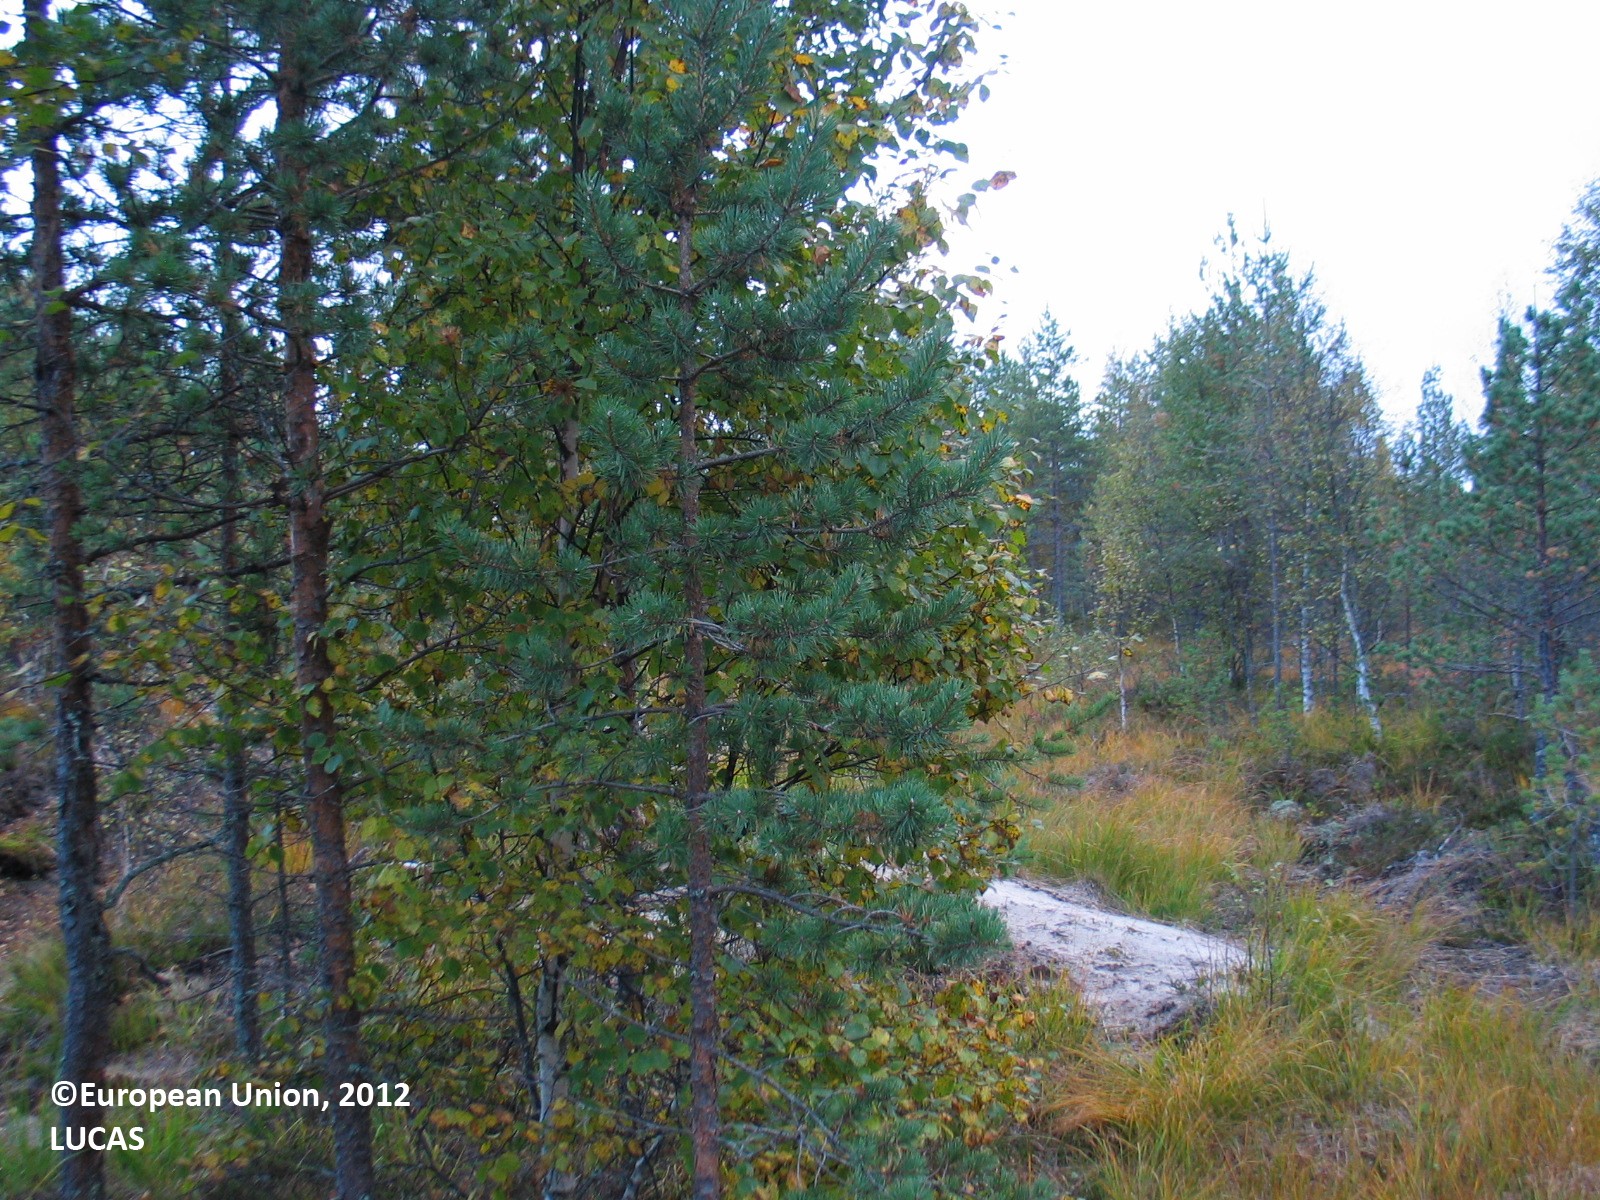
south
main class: Woodland
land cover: Pine dominated coniferous woodland
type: mire and swamp forests
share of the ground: 25 - 50 %
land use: Forestry
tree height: > 5 m
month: September
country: FI
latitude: 65.5402
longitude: 25.6425
